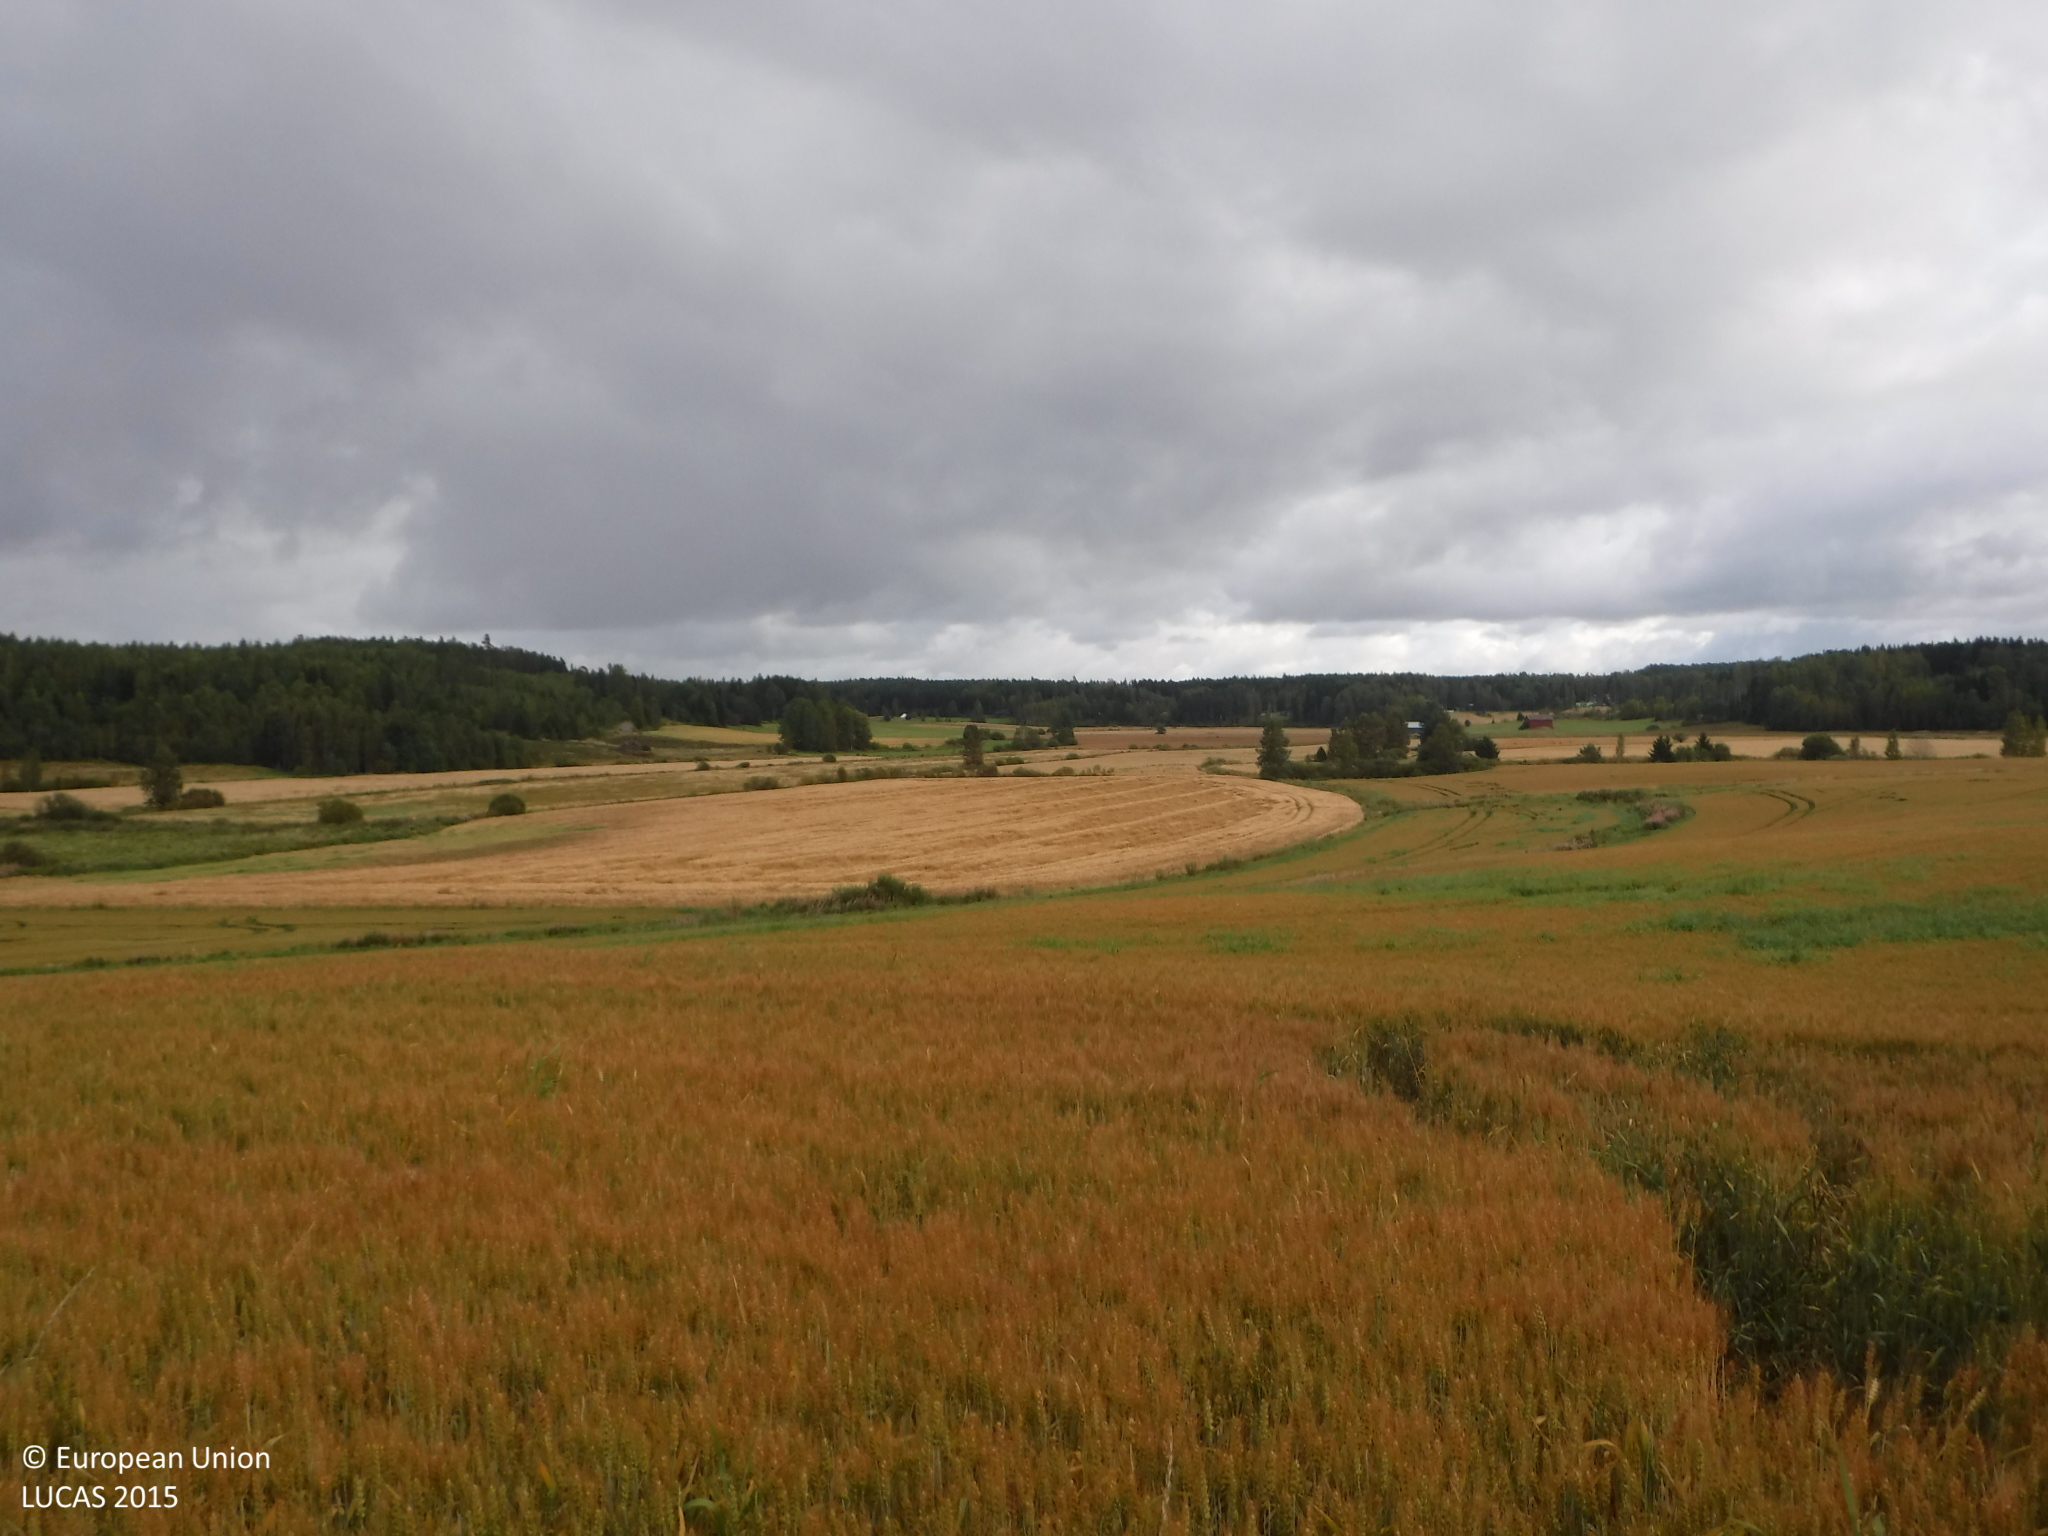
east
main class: Cropland
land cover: Common wheat
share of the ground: > 75 %
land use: Agriculture (excluding fallow land and kitchen gardens)
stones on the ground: < 10 %
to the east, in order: Common wheat; Grass margins; Ditches and canals; Grass margins; Common wheat; Grass margins; Ditches and canals; Spontaneously vegetated surfaces; Ditches and canals; Barley
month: September
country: FI
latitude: 61.3408
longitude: 23.1017
